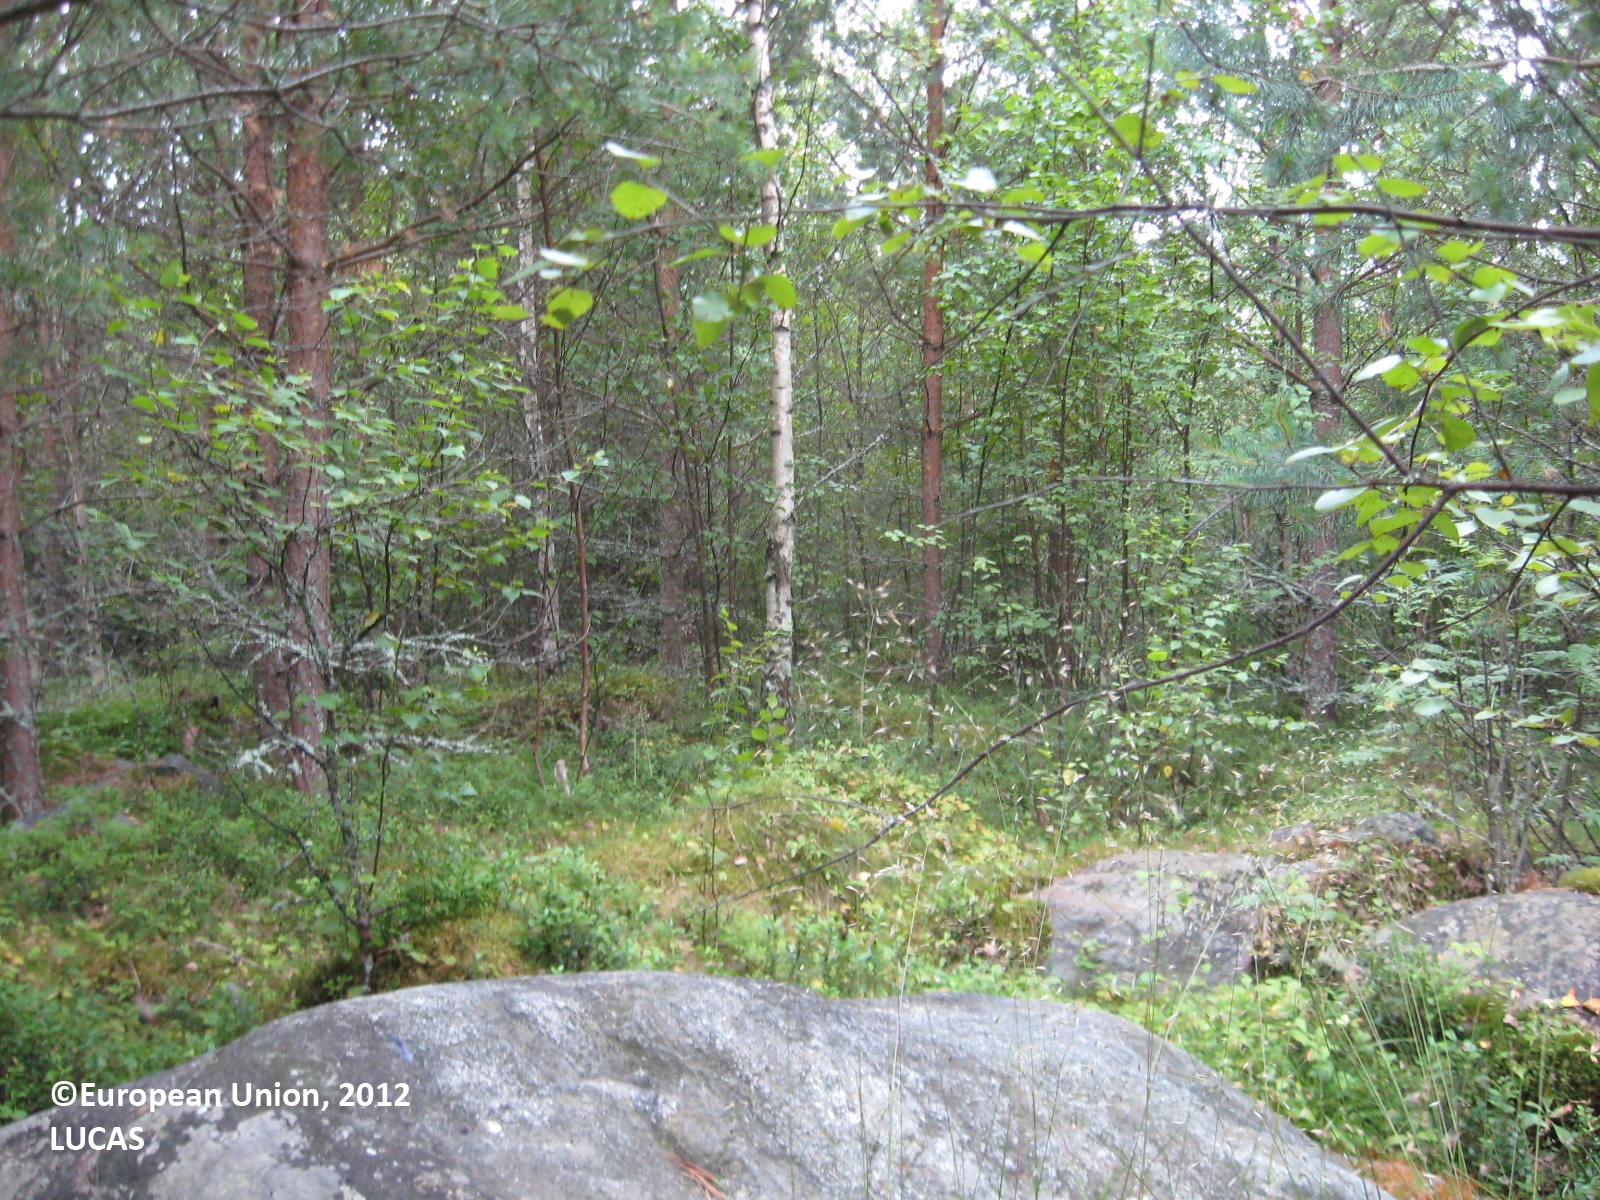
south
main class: Woodland
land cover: Other mixed woodland
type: boreal forest
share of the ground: > 75 %
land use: Forestry
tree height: > 5 m
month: July
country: FI
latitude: 61.8800
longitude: 21.4780
